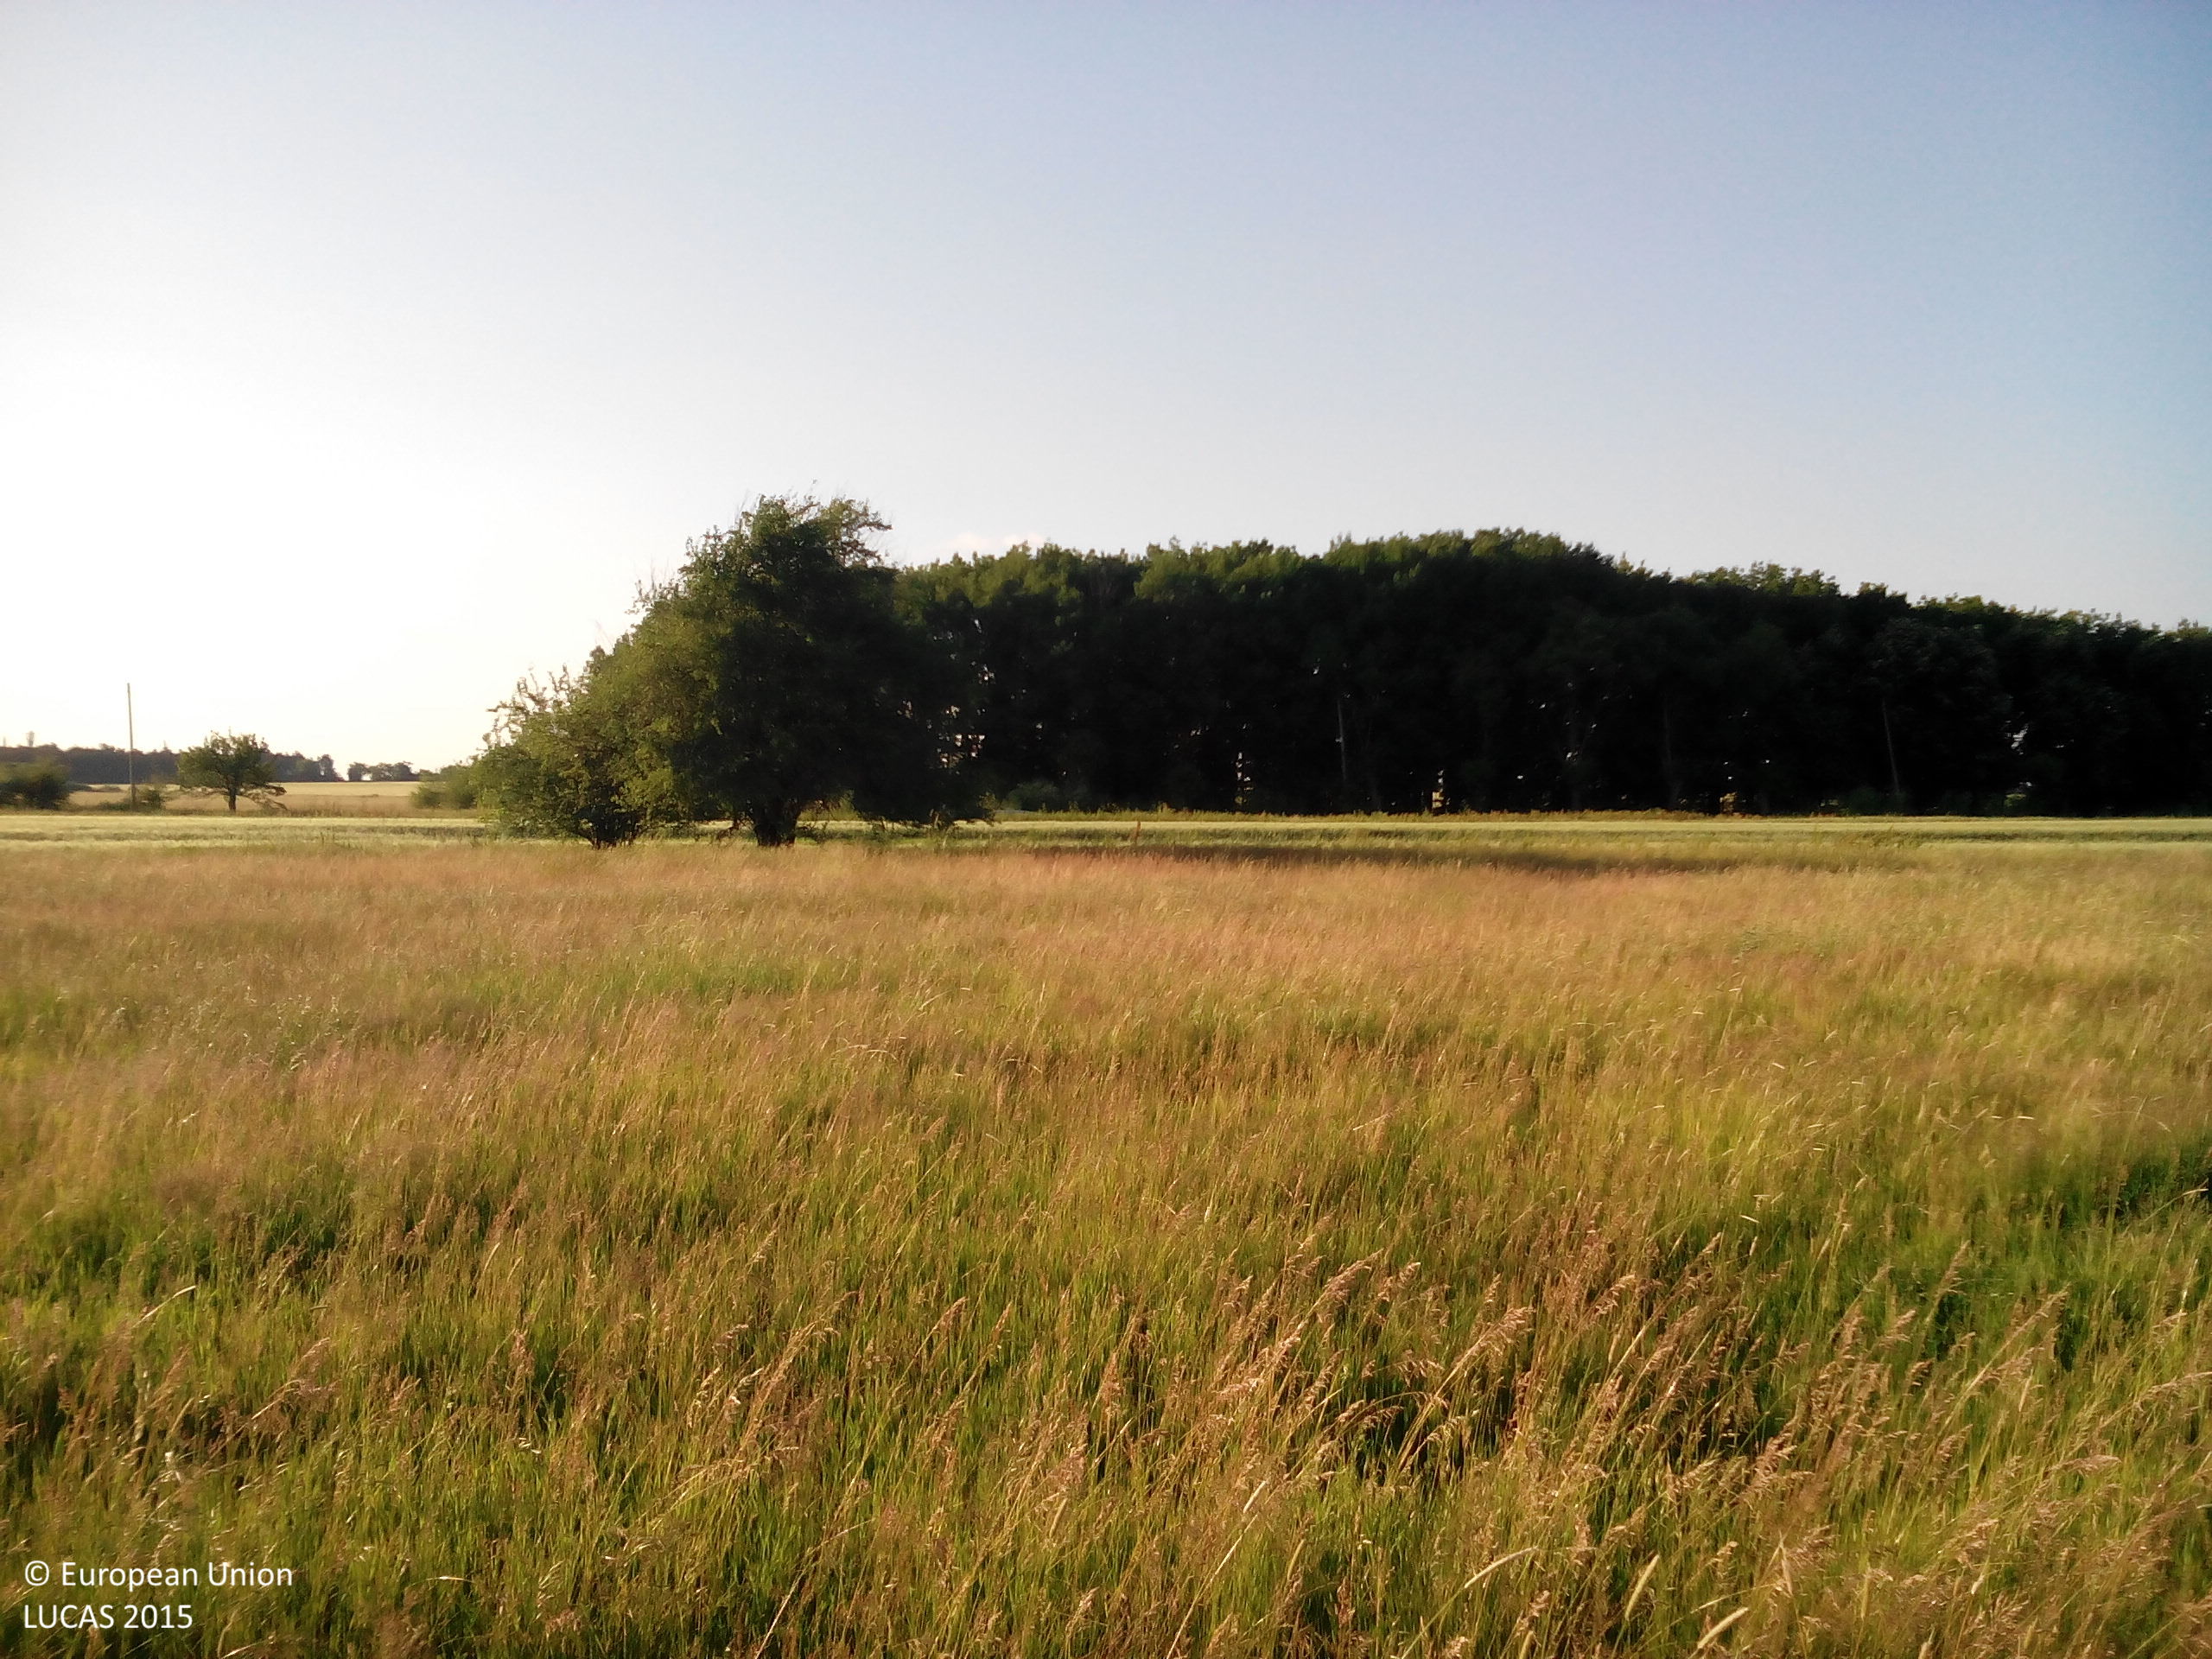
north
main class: Grassland
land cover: Grassland without tree/shrub cover
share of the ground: > 75 %
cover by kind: herbaceous plants 100 %
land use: Agriculture (excluding fallow land and kitchen gardens)
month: May
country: BG
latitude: 43.4272
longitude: 23.7721
